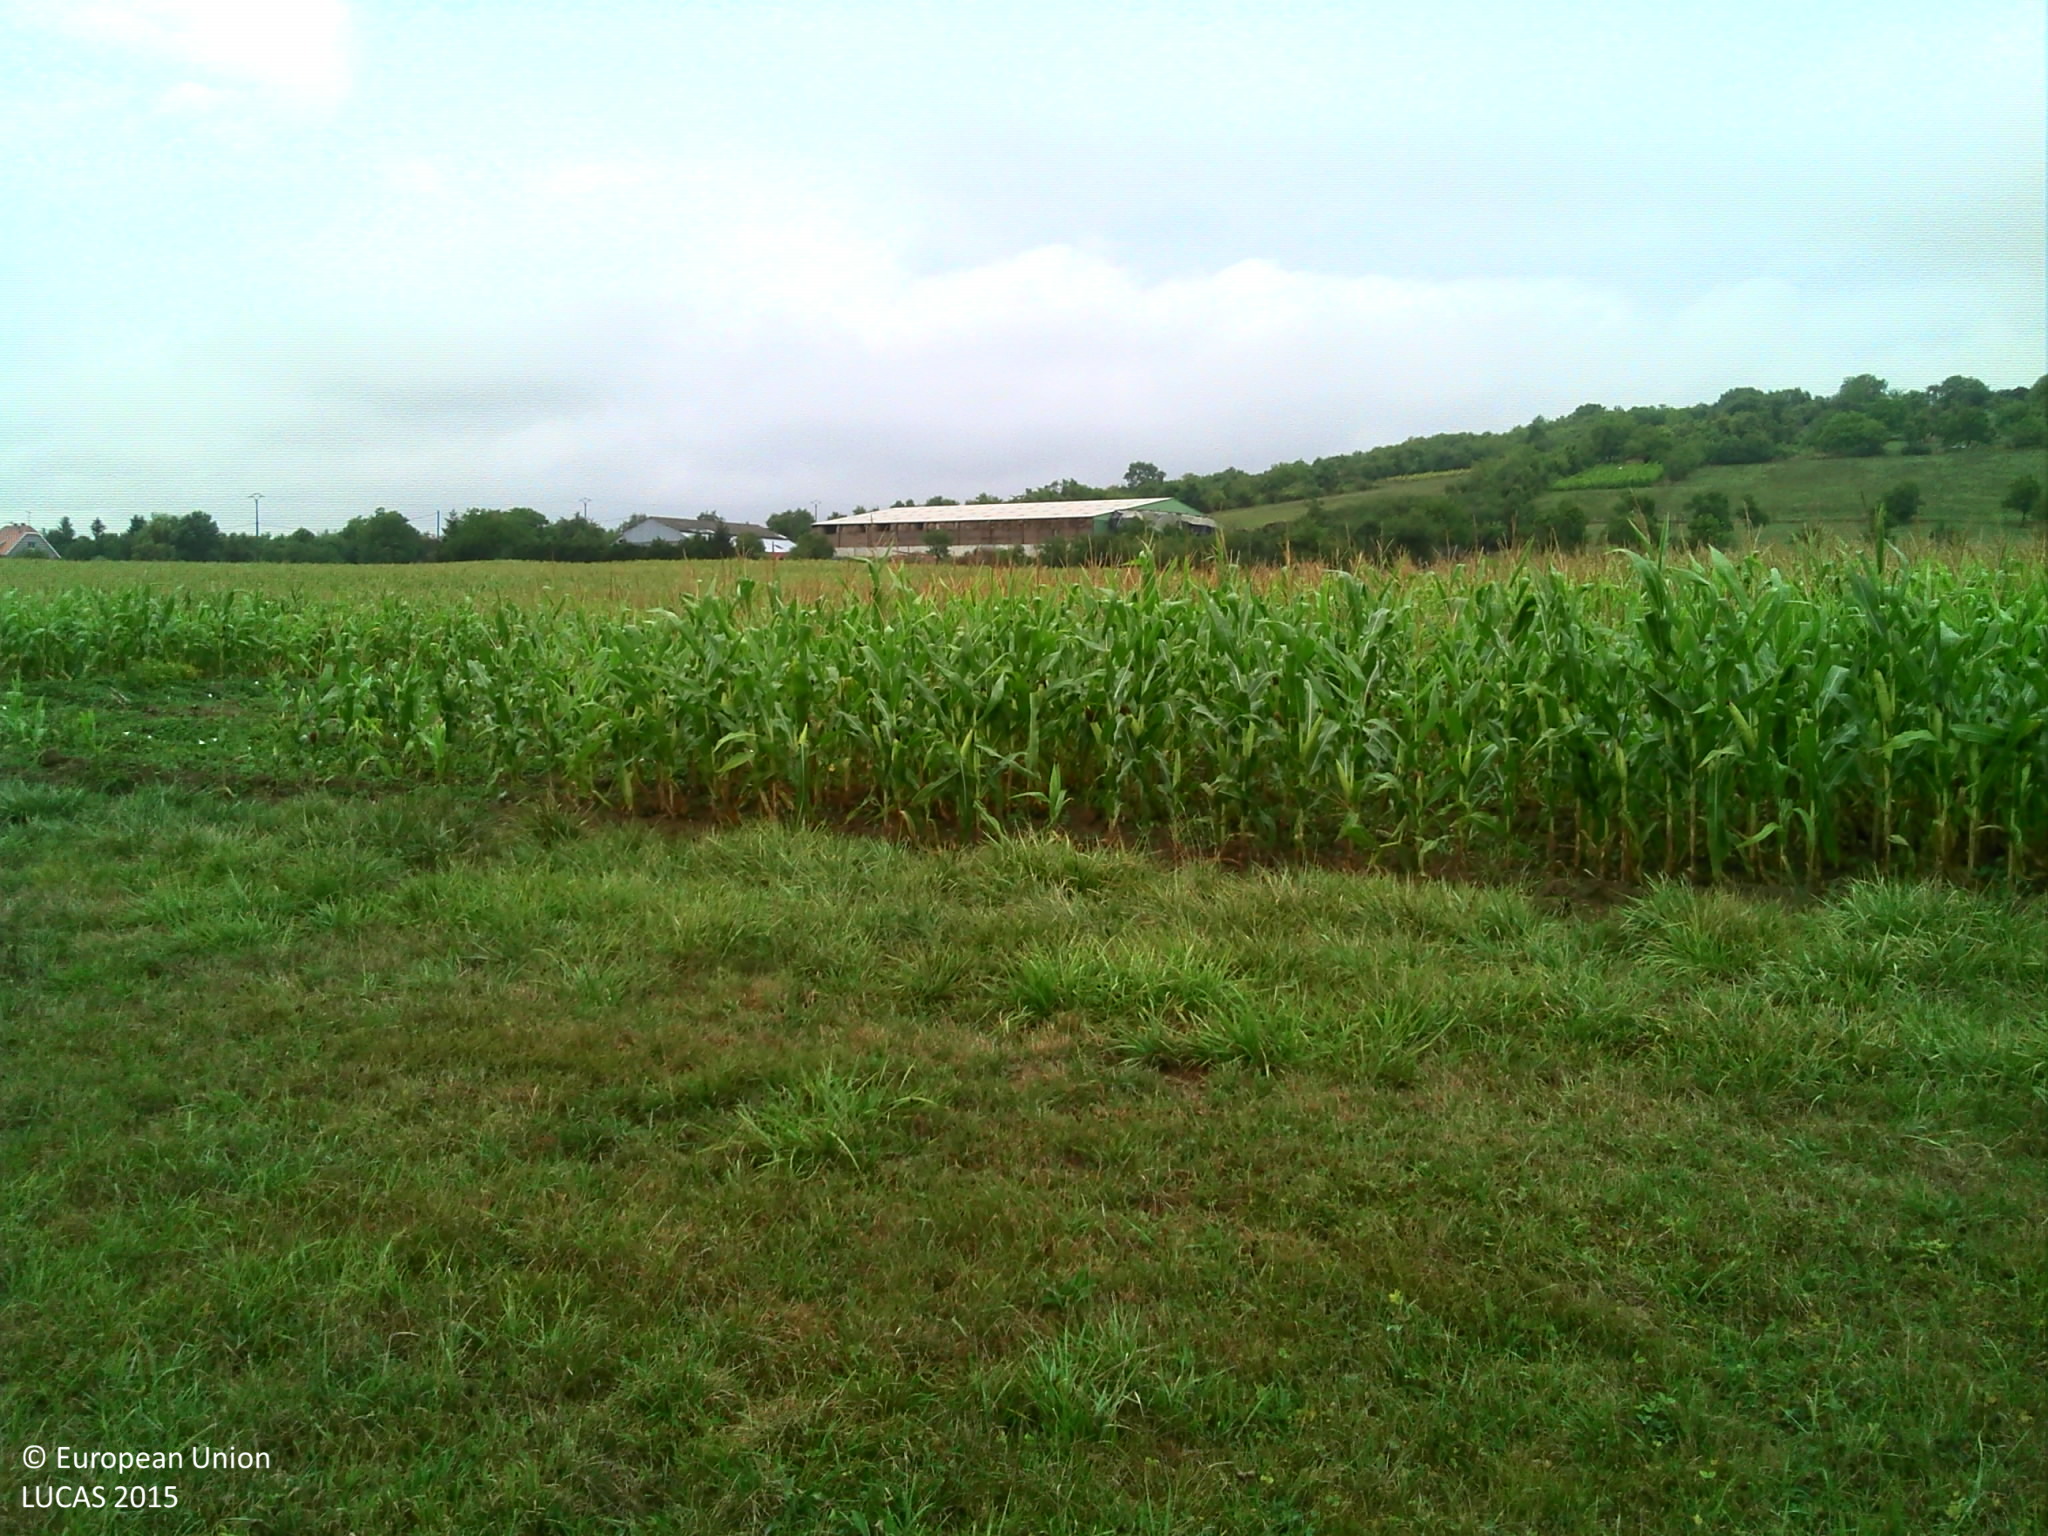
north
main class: Grassland
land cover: Grassland without tree/shrub cover
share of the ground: > 75 %
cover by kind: herbaceous plants 100 %
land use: Agriculture (excluding fallow land and kitchen gardens)
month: August
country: FR
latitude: 48.8081
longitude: 7.5361
